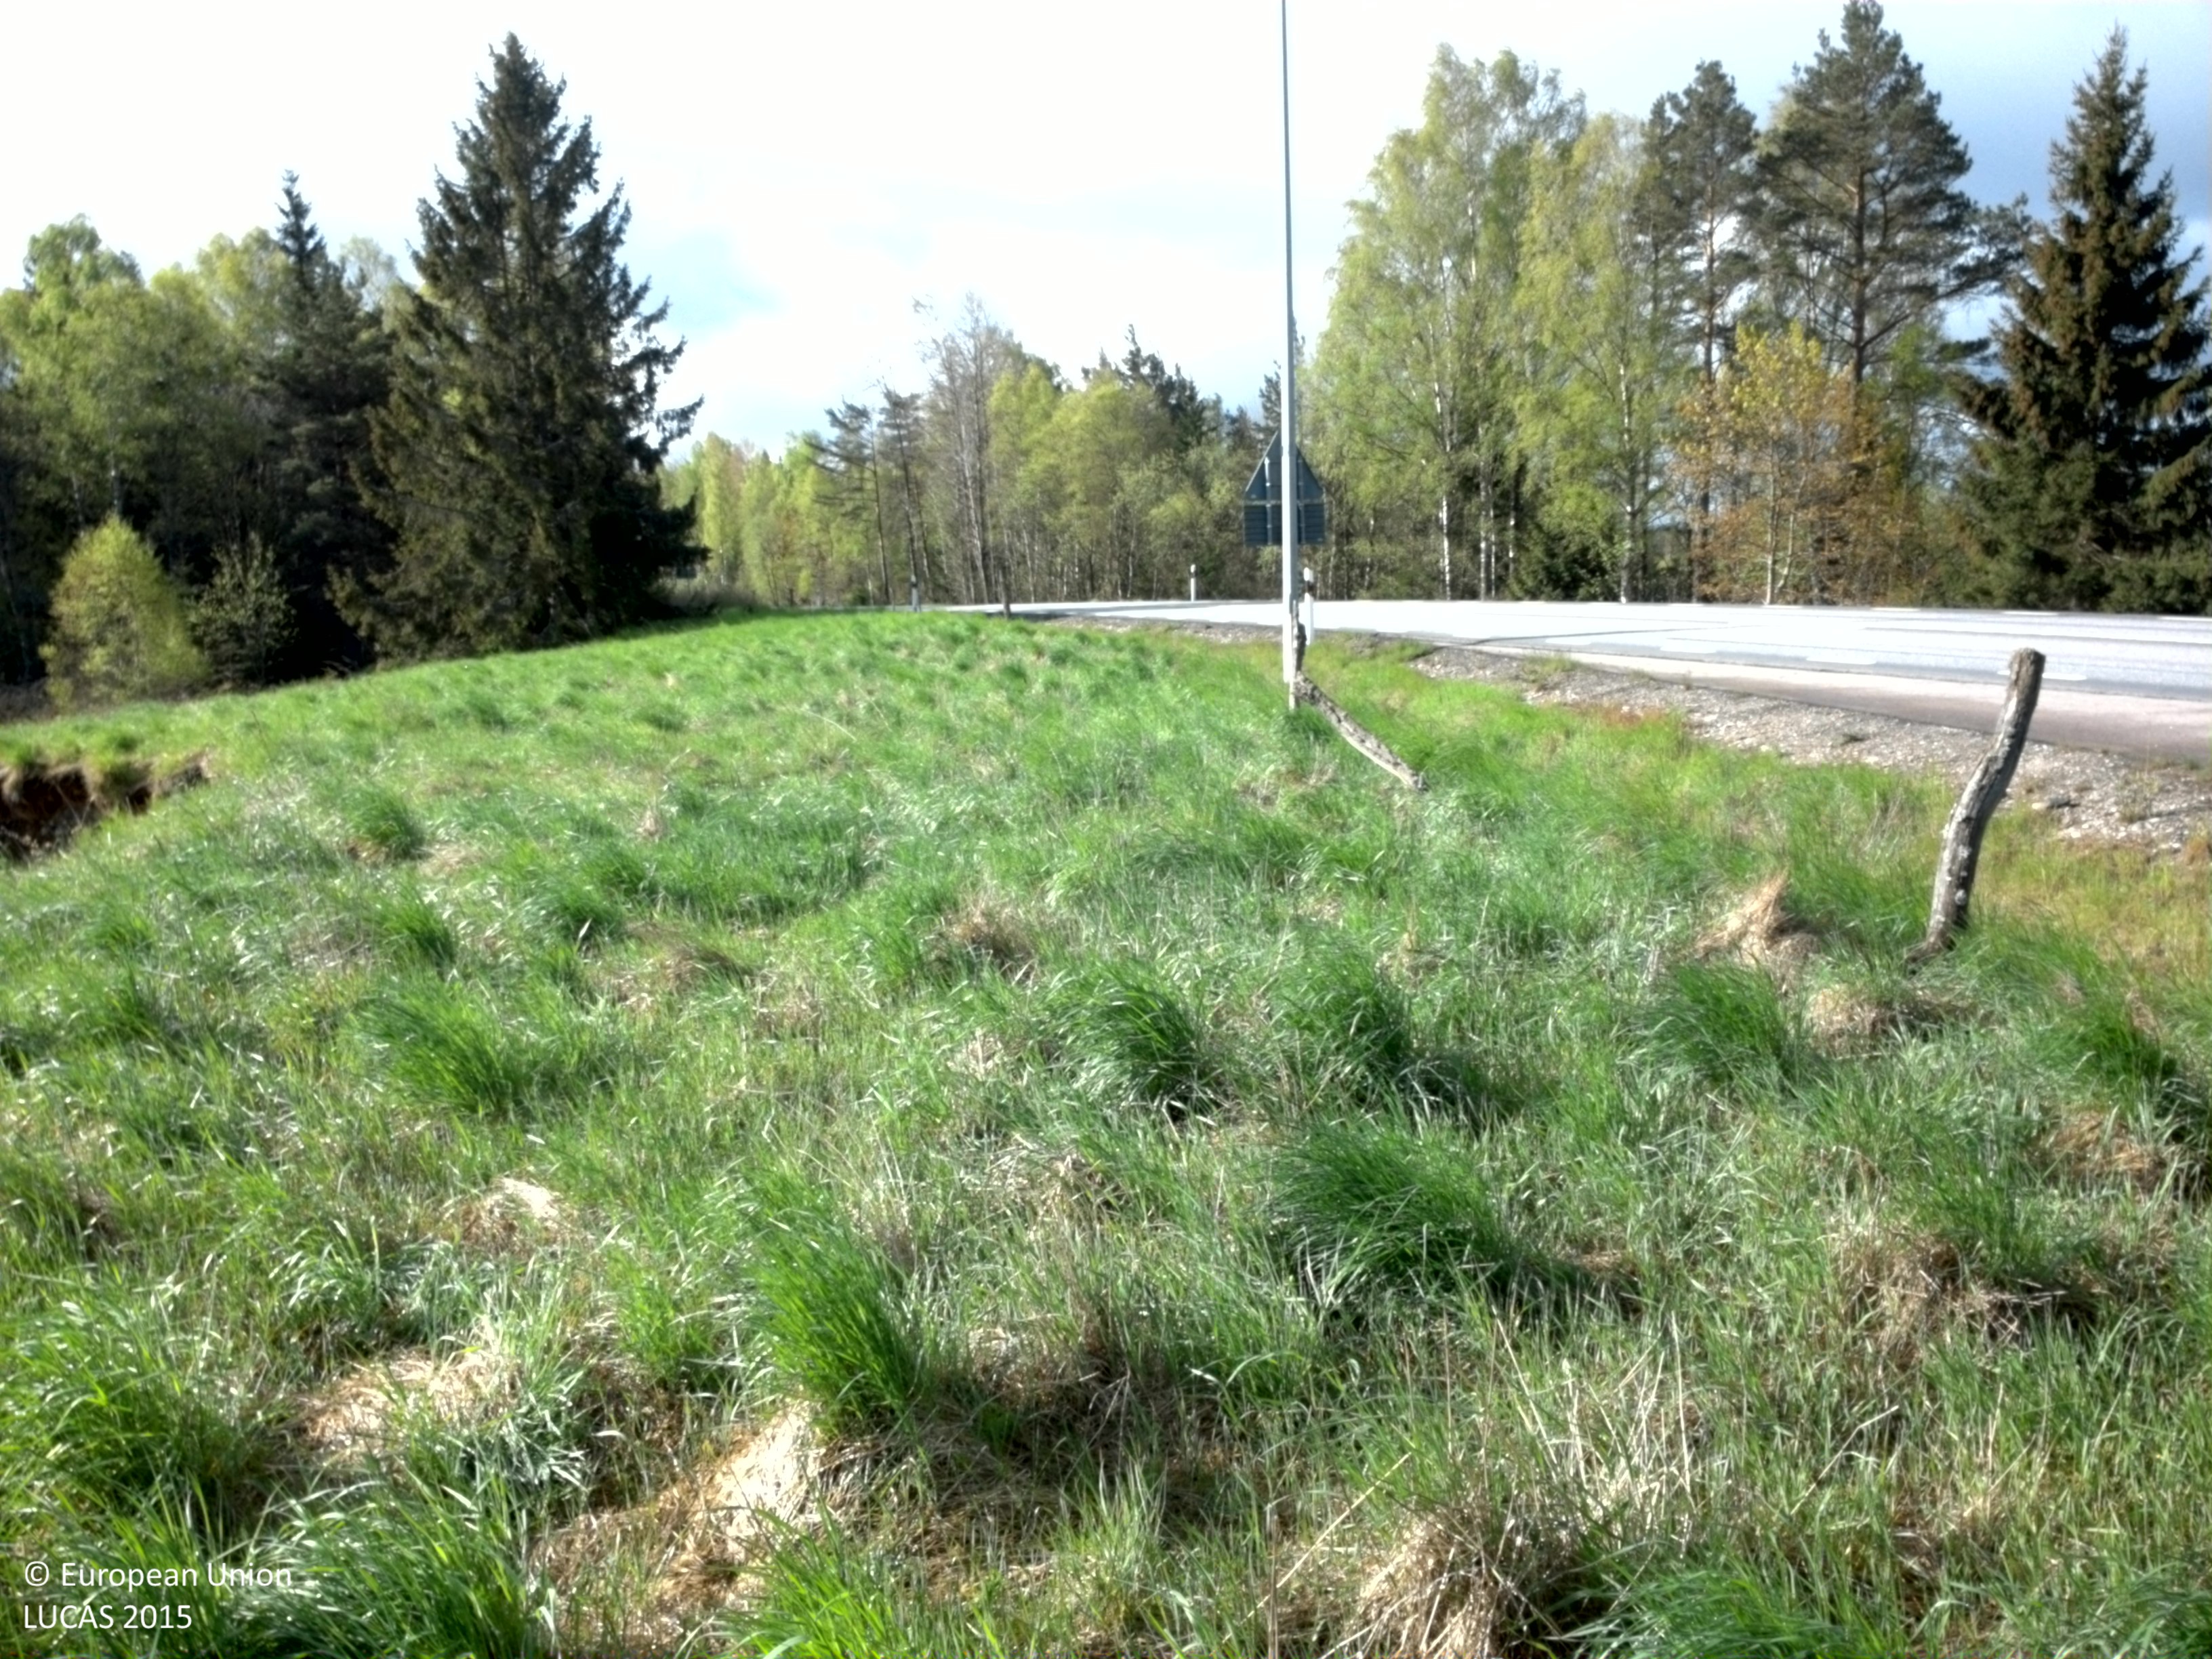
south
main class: Grassland
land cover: Grassland without tree/shrub cover
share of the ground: > 75 %
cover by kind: herbaceous plants 100 %
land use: Agriculture (excluding fallow land and kitchen gardens)
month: May
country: SE
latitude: 56.8342
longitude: 14.8651
